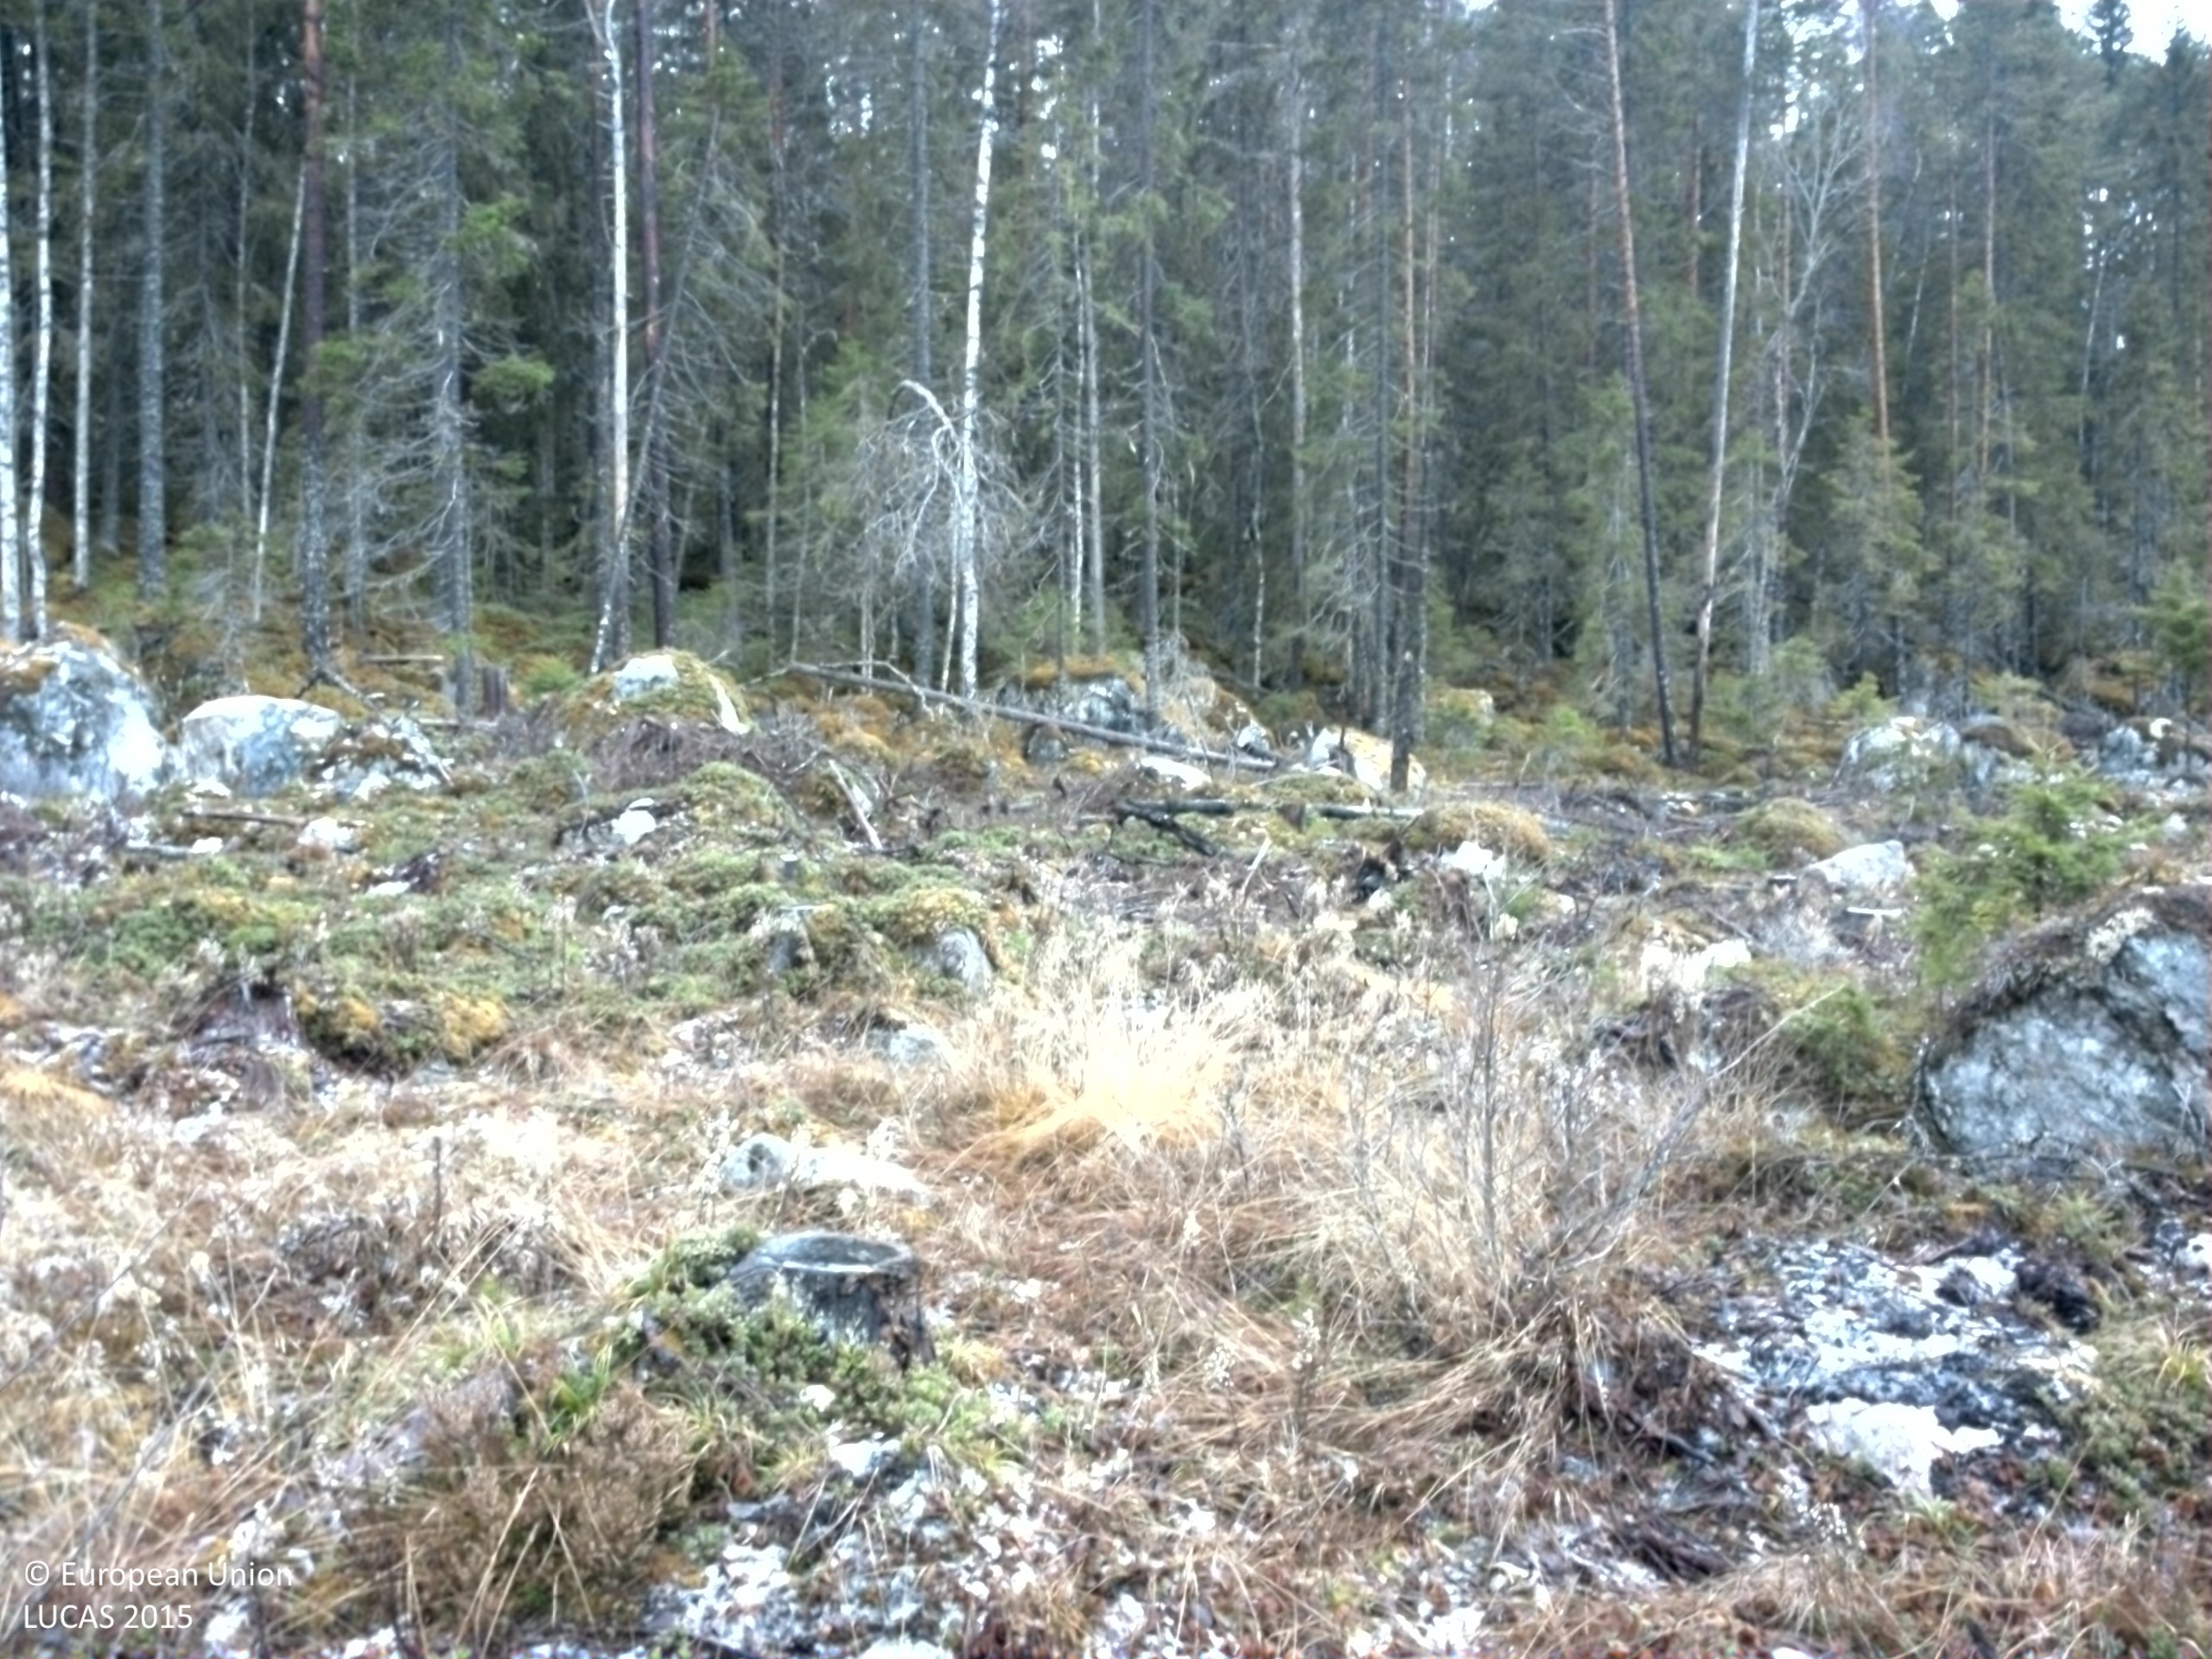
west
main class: Woodland
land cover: Spruce dominated mixed woodland
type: boreal forest
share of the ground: 10 - 25 %
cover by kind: shrubs 35 %, herbaceous plants 20 %, lichens and mosses 20 %, coniferous forest trees 10 %, consolidated bare surface 10 %, broadleaved forest trees 5 %
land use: Forestry
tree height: < 5 m
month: November
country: SE
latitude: 61.4300
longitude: 15.4389
